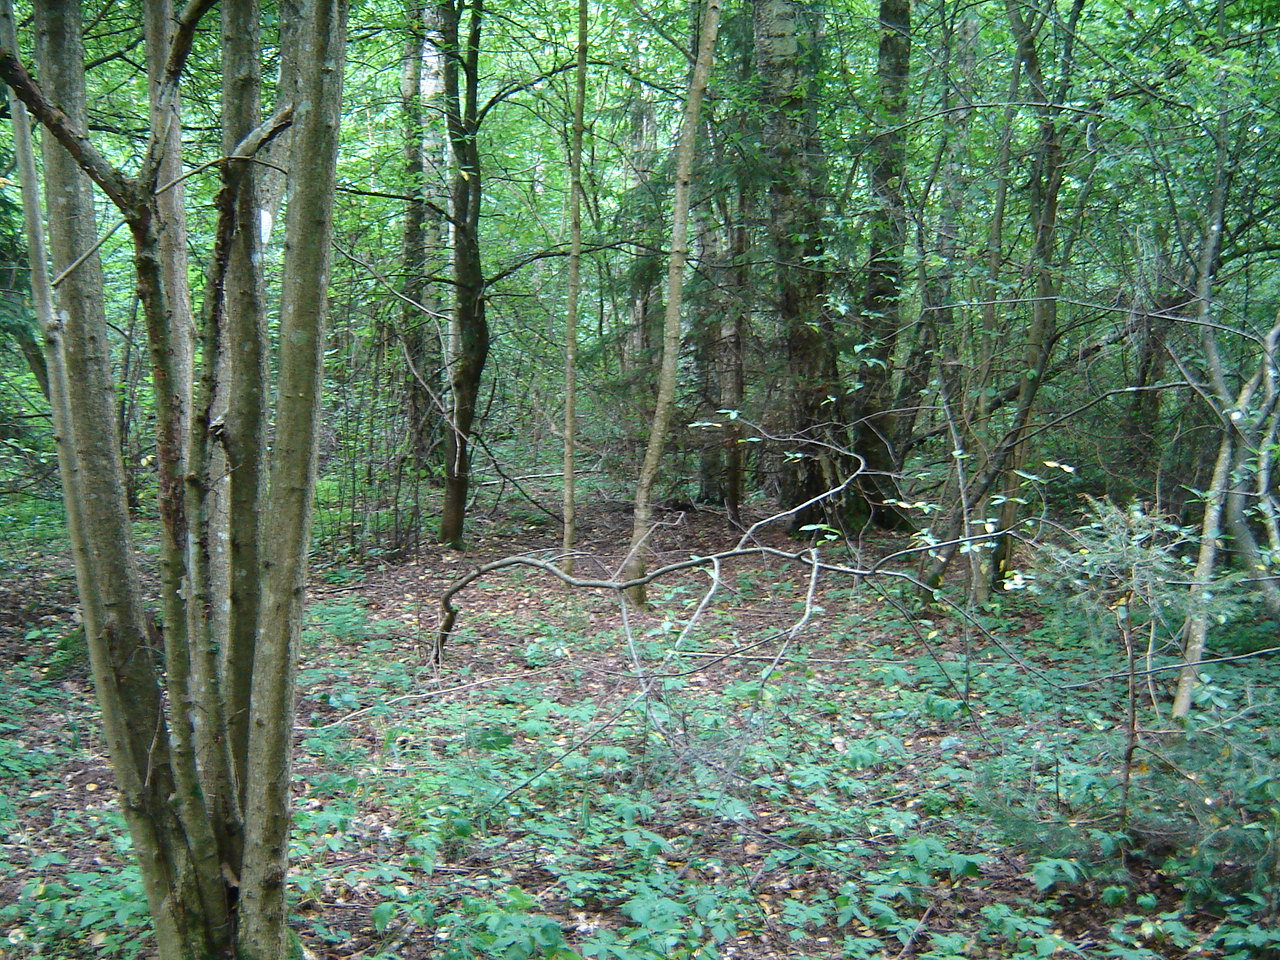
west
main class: Woodland
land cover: Other mixed woodland
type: hemiboreal forest and nemoral coniferous forest and mixed broadleaved-coniferous forest
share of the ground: > 75 %
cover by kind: broadleaved forest trees 50 %, coniferous forest trees 45 %, herbaceous plants 5 %
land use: Forestry
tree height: > 5 m
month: July
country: LT
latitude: 55.3129
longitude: 25.0342
